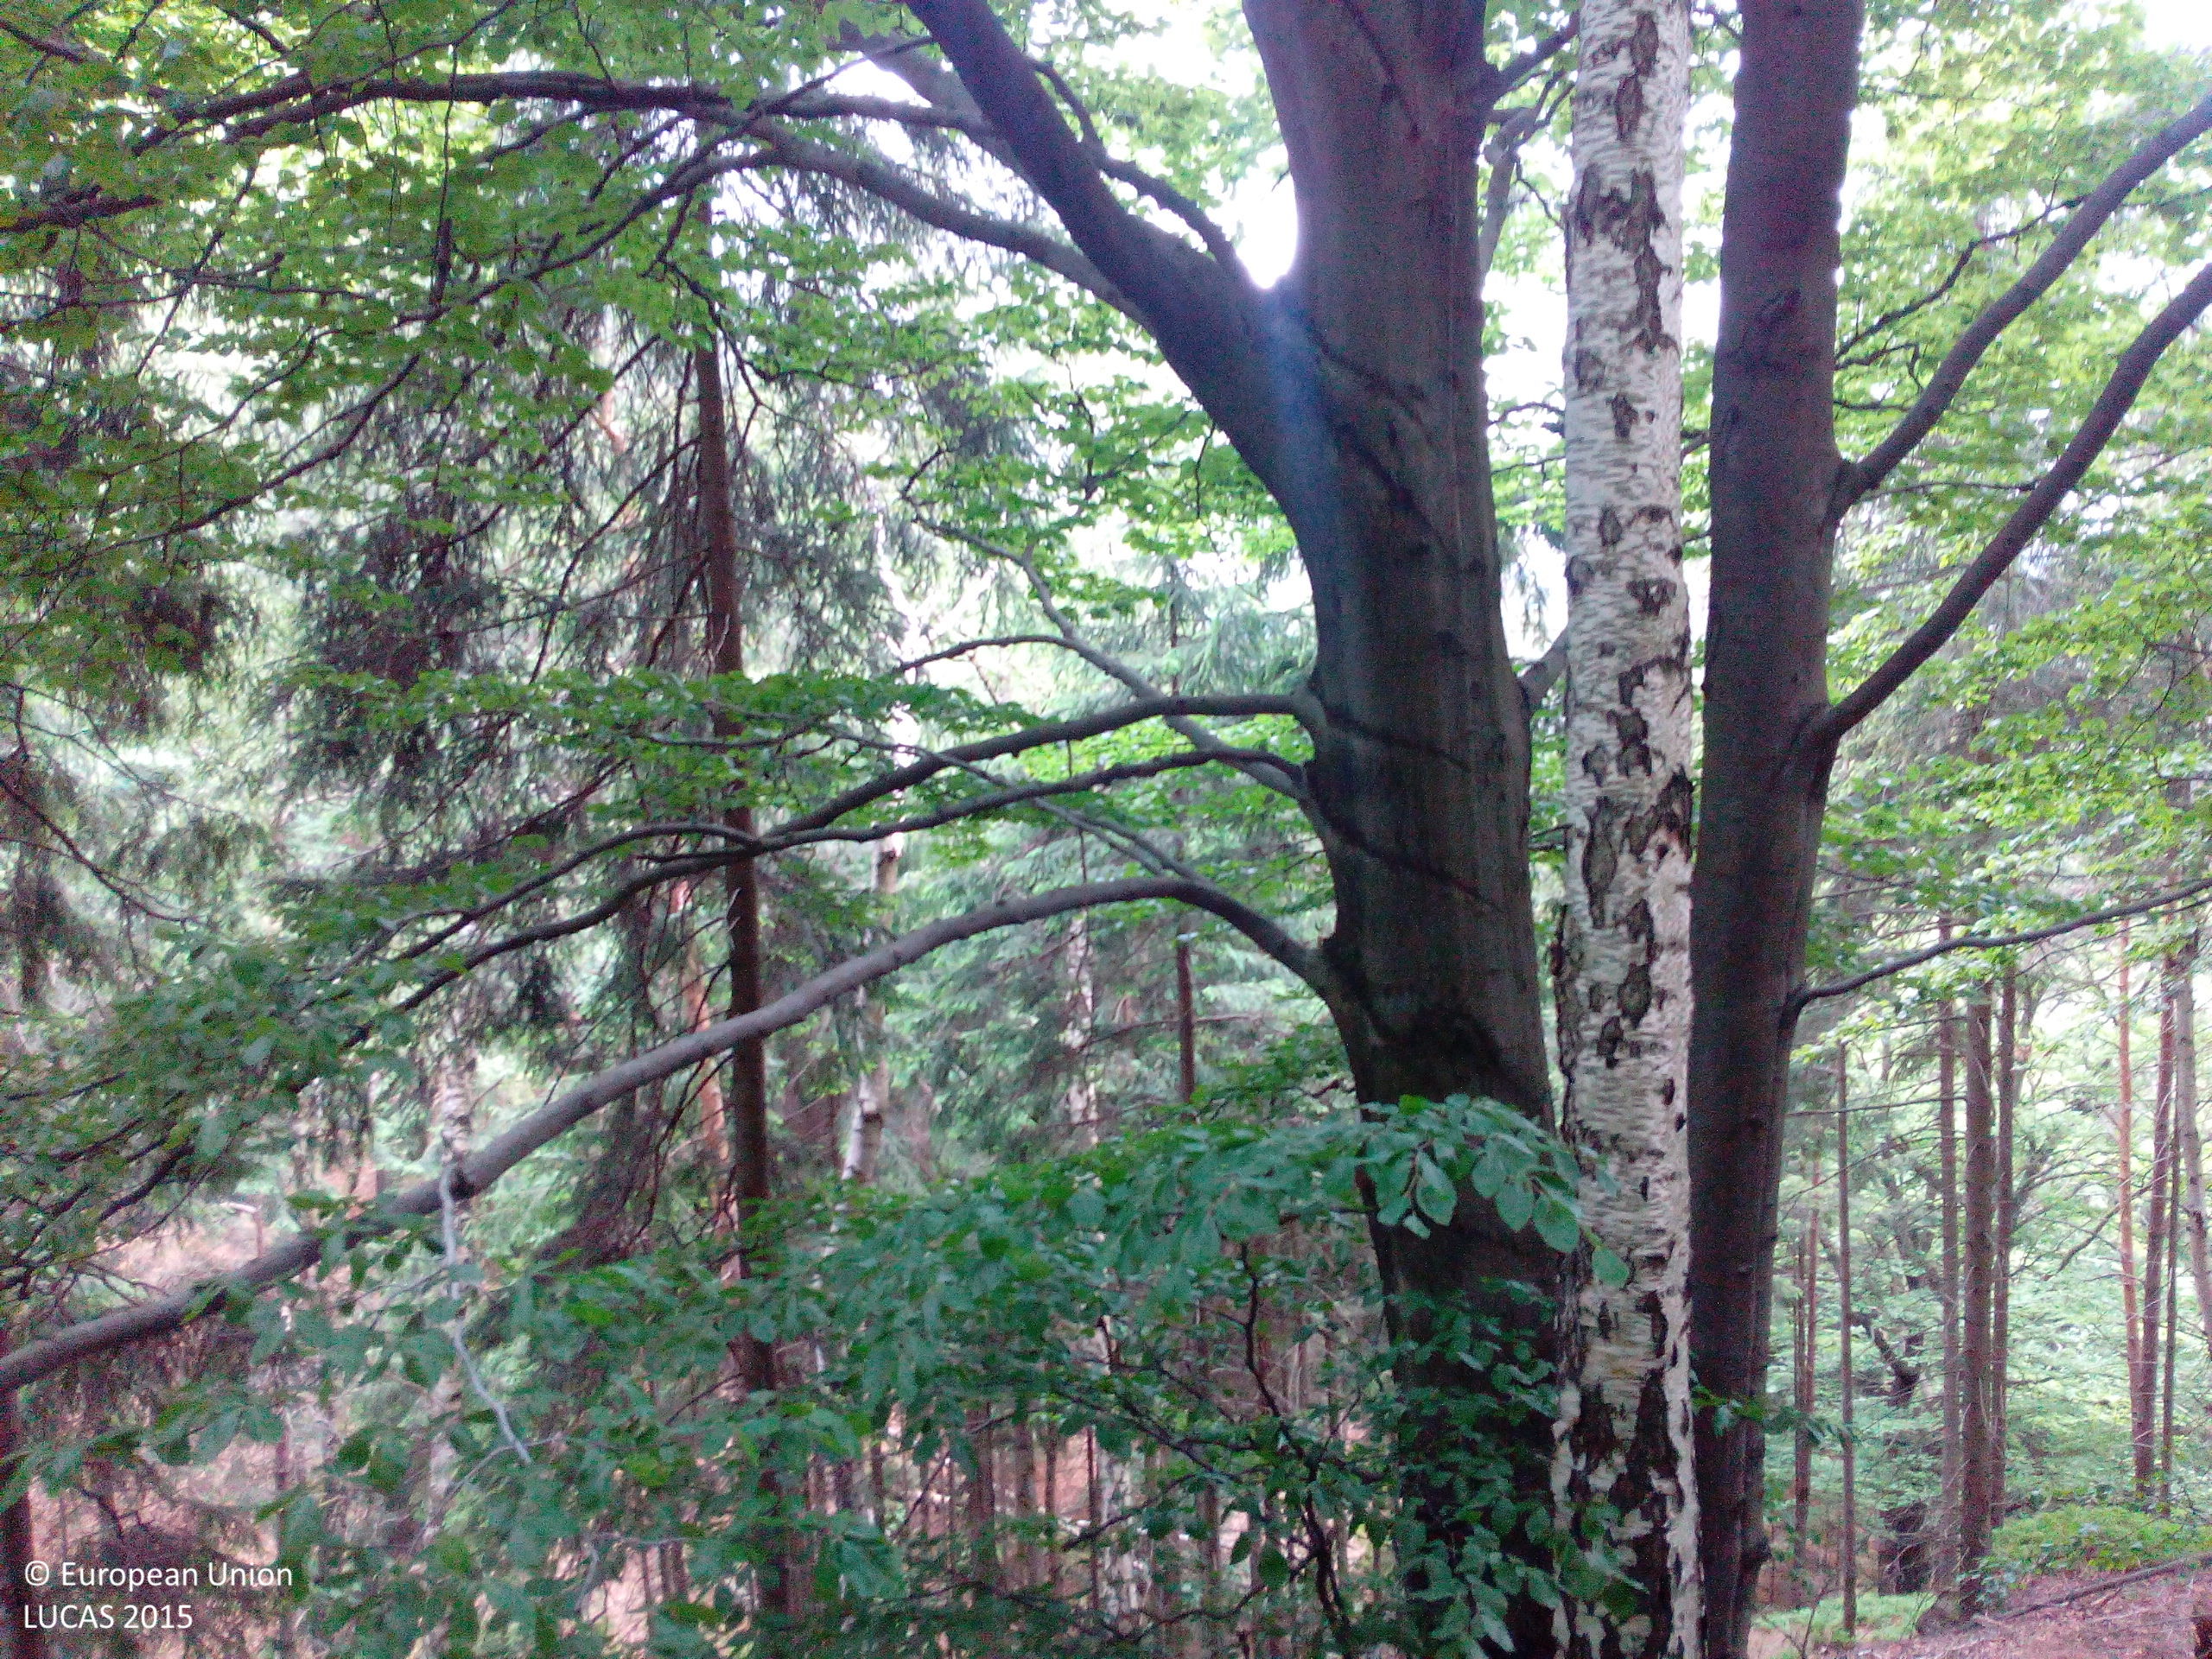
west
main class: Woodland
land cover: Pine dominated mixed woodland
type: hemiboreal forest and nemoral coniferous forest and mixed broadleaved-coniferous forest
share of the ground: > 75 %
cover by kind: coniferous forest trees 60 %, broadleaved forest trees 40 %
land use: Forestry
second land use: Amenities, museums, leisure
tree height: > 5 m
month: June
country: DE
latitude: 50.8951
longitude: 14.3094
